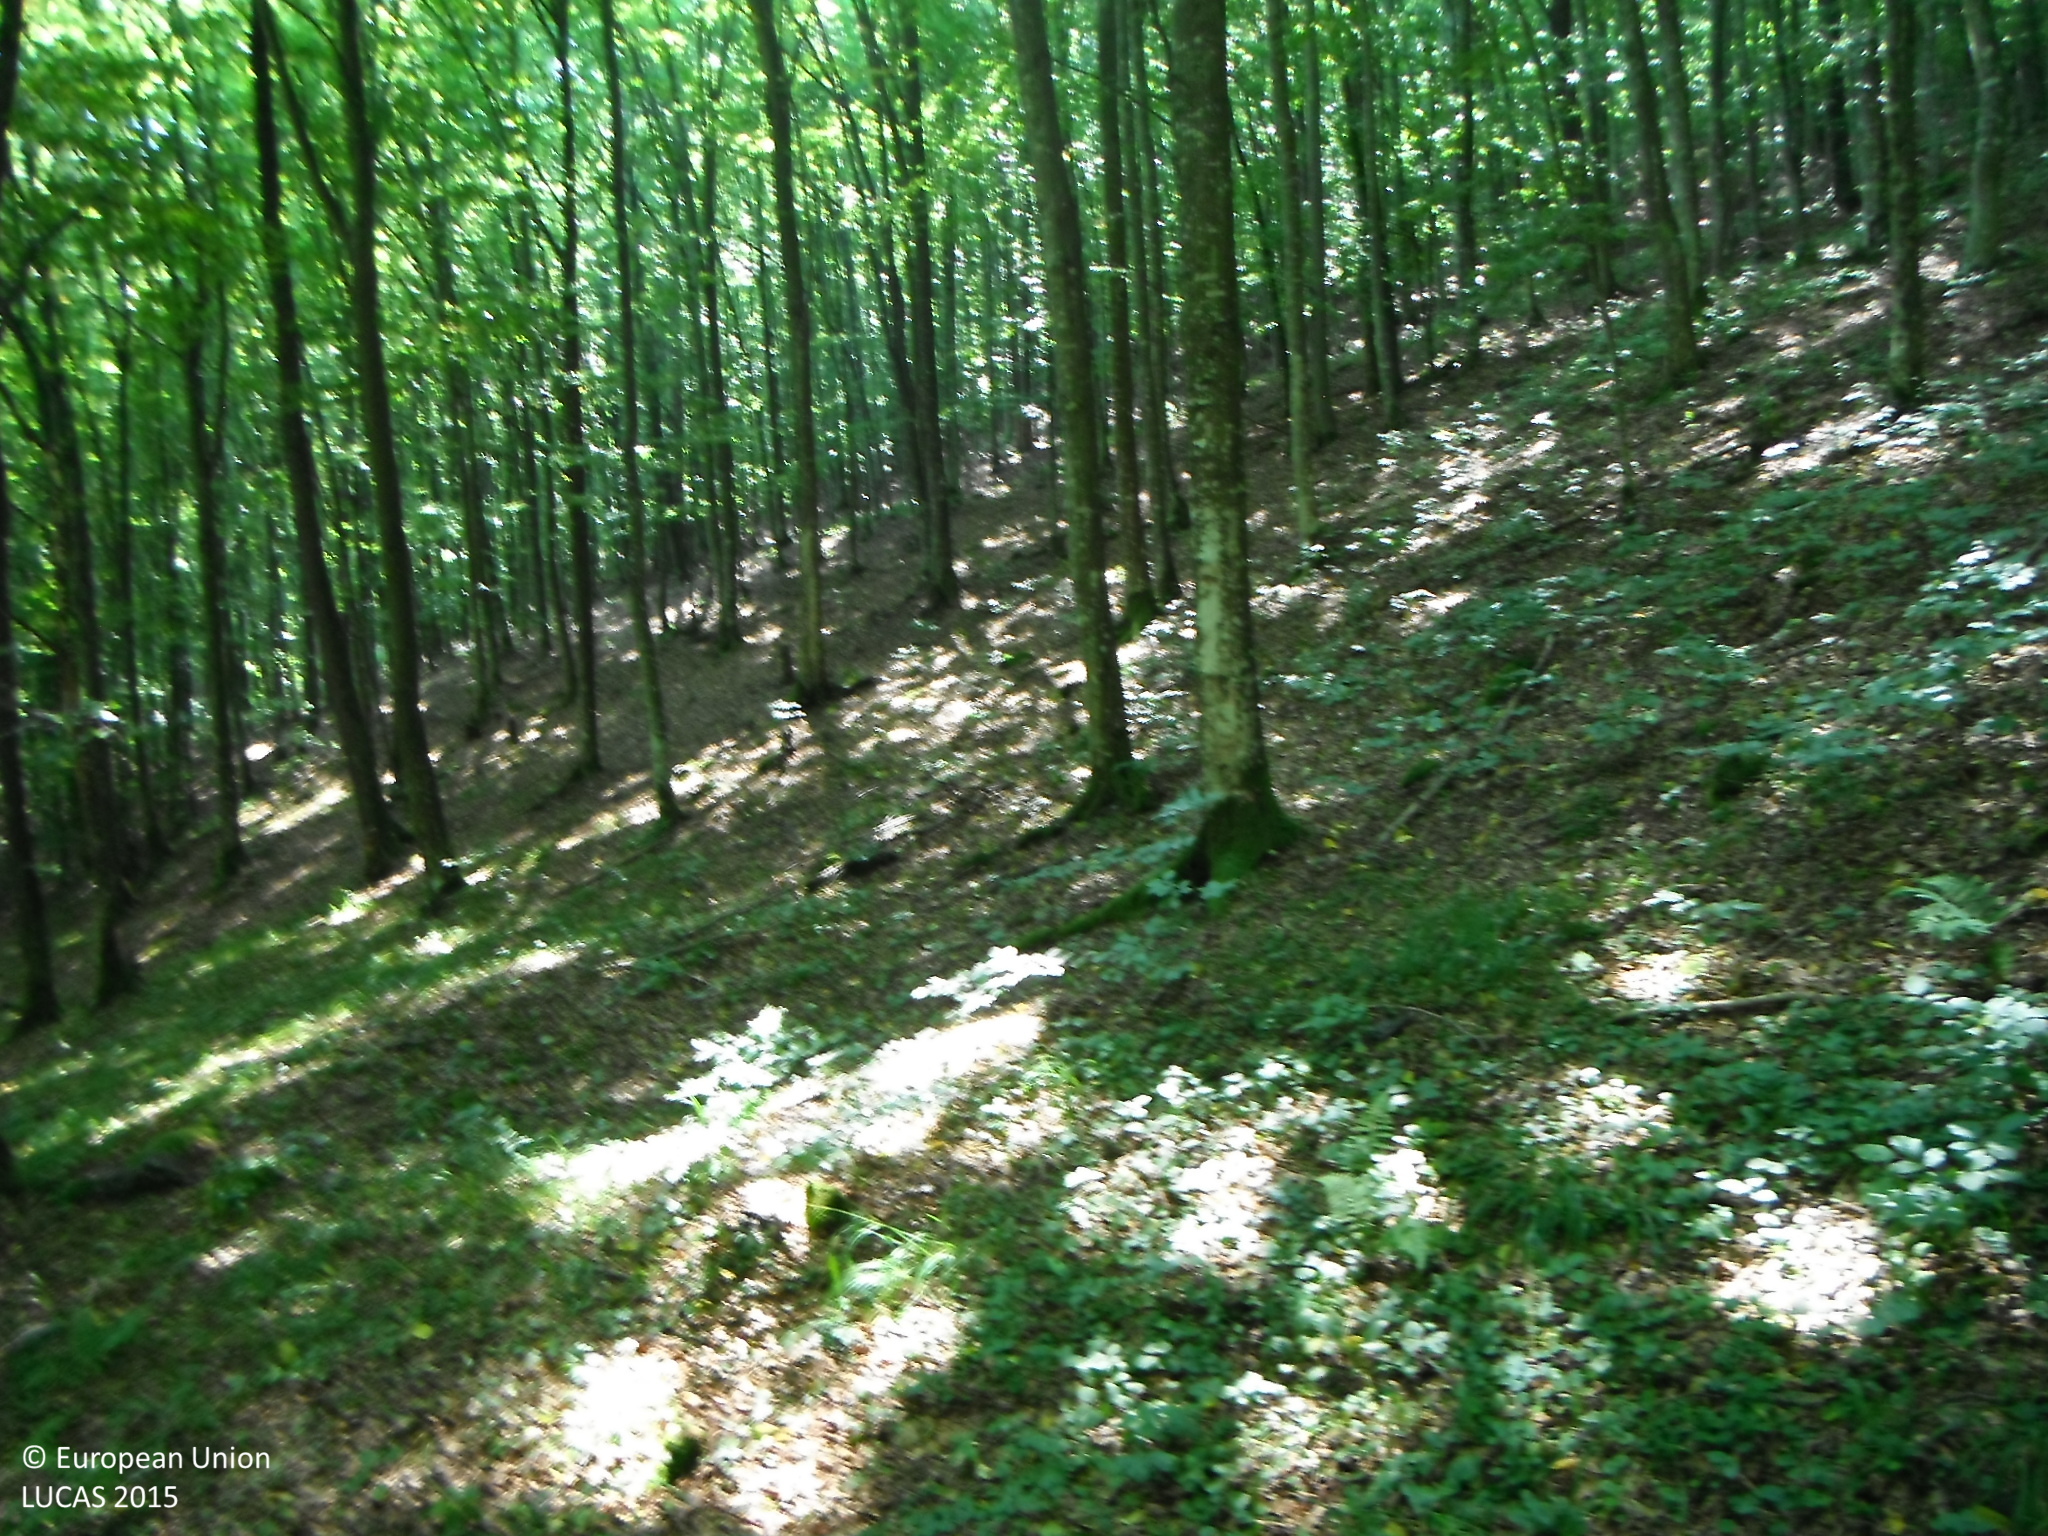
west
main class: Woodland
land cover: Broadleaved woodland
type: mesophytic deciduous forest
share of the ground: > 75 %
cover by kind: broadleaved forest trees 100 %
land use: Forestry
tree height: > 5 m
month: August
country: SK
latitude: 48.6942
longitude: 20.5650
